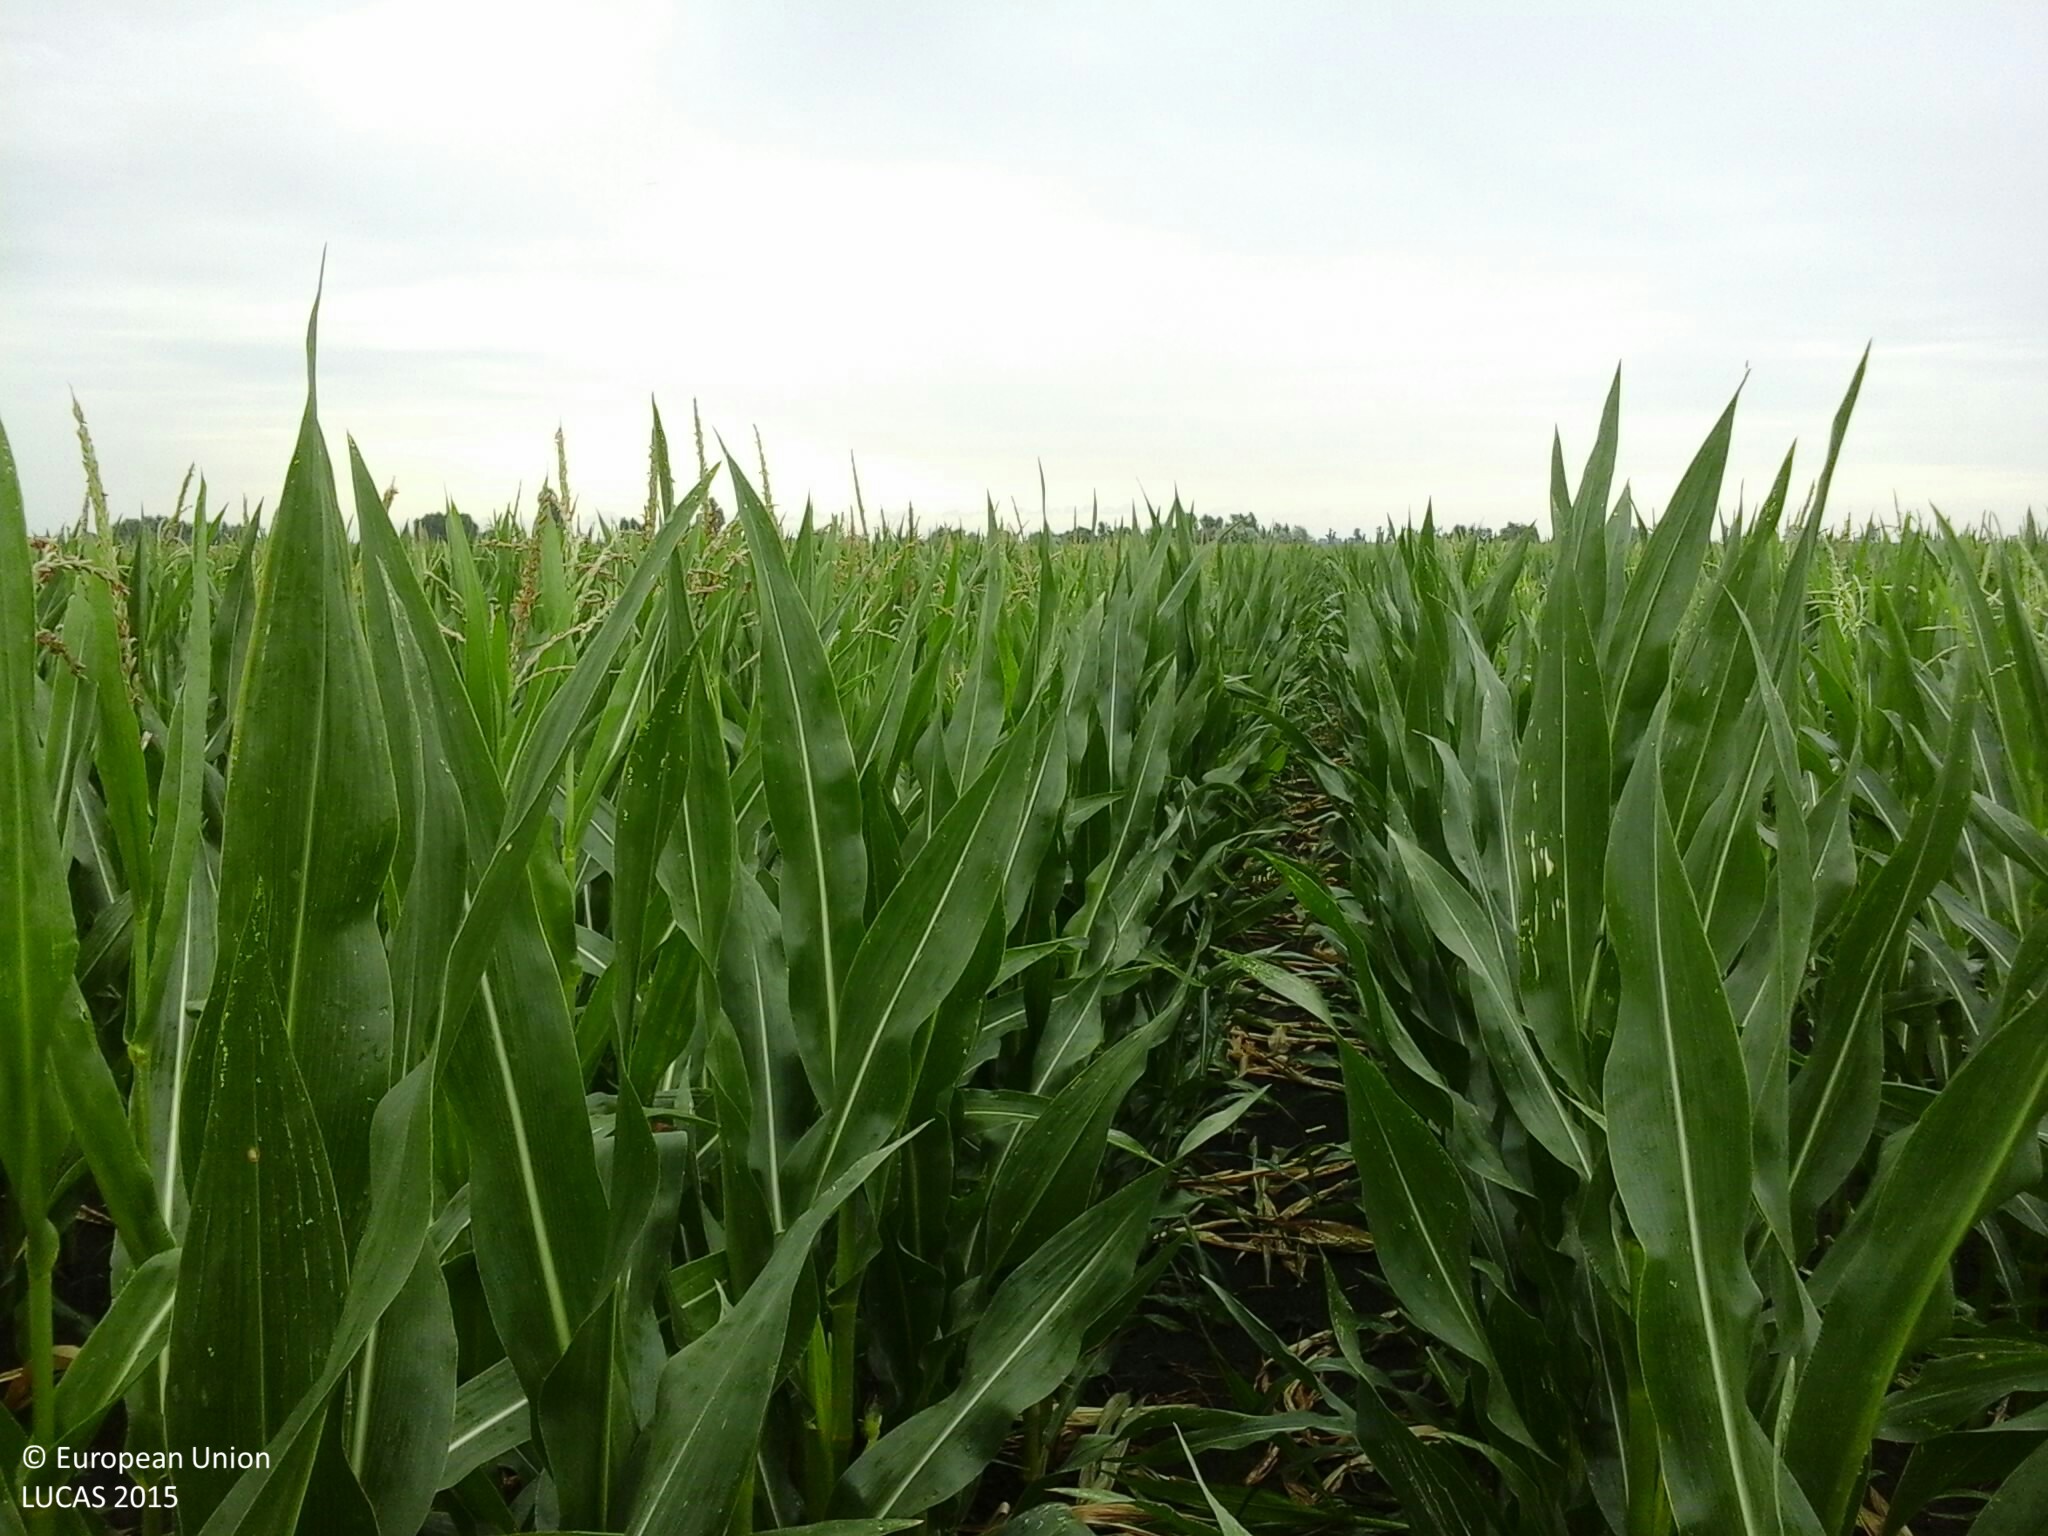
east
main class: Cropland
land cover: Maize
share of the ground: > 75 %
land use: Agriculture (excluding fallow land and kitchen gardens)
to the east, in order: Maize
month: July
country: HU
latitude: 46.9760
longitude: 20.3196
